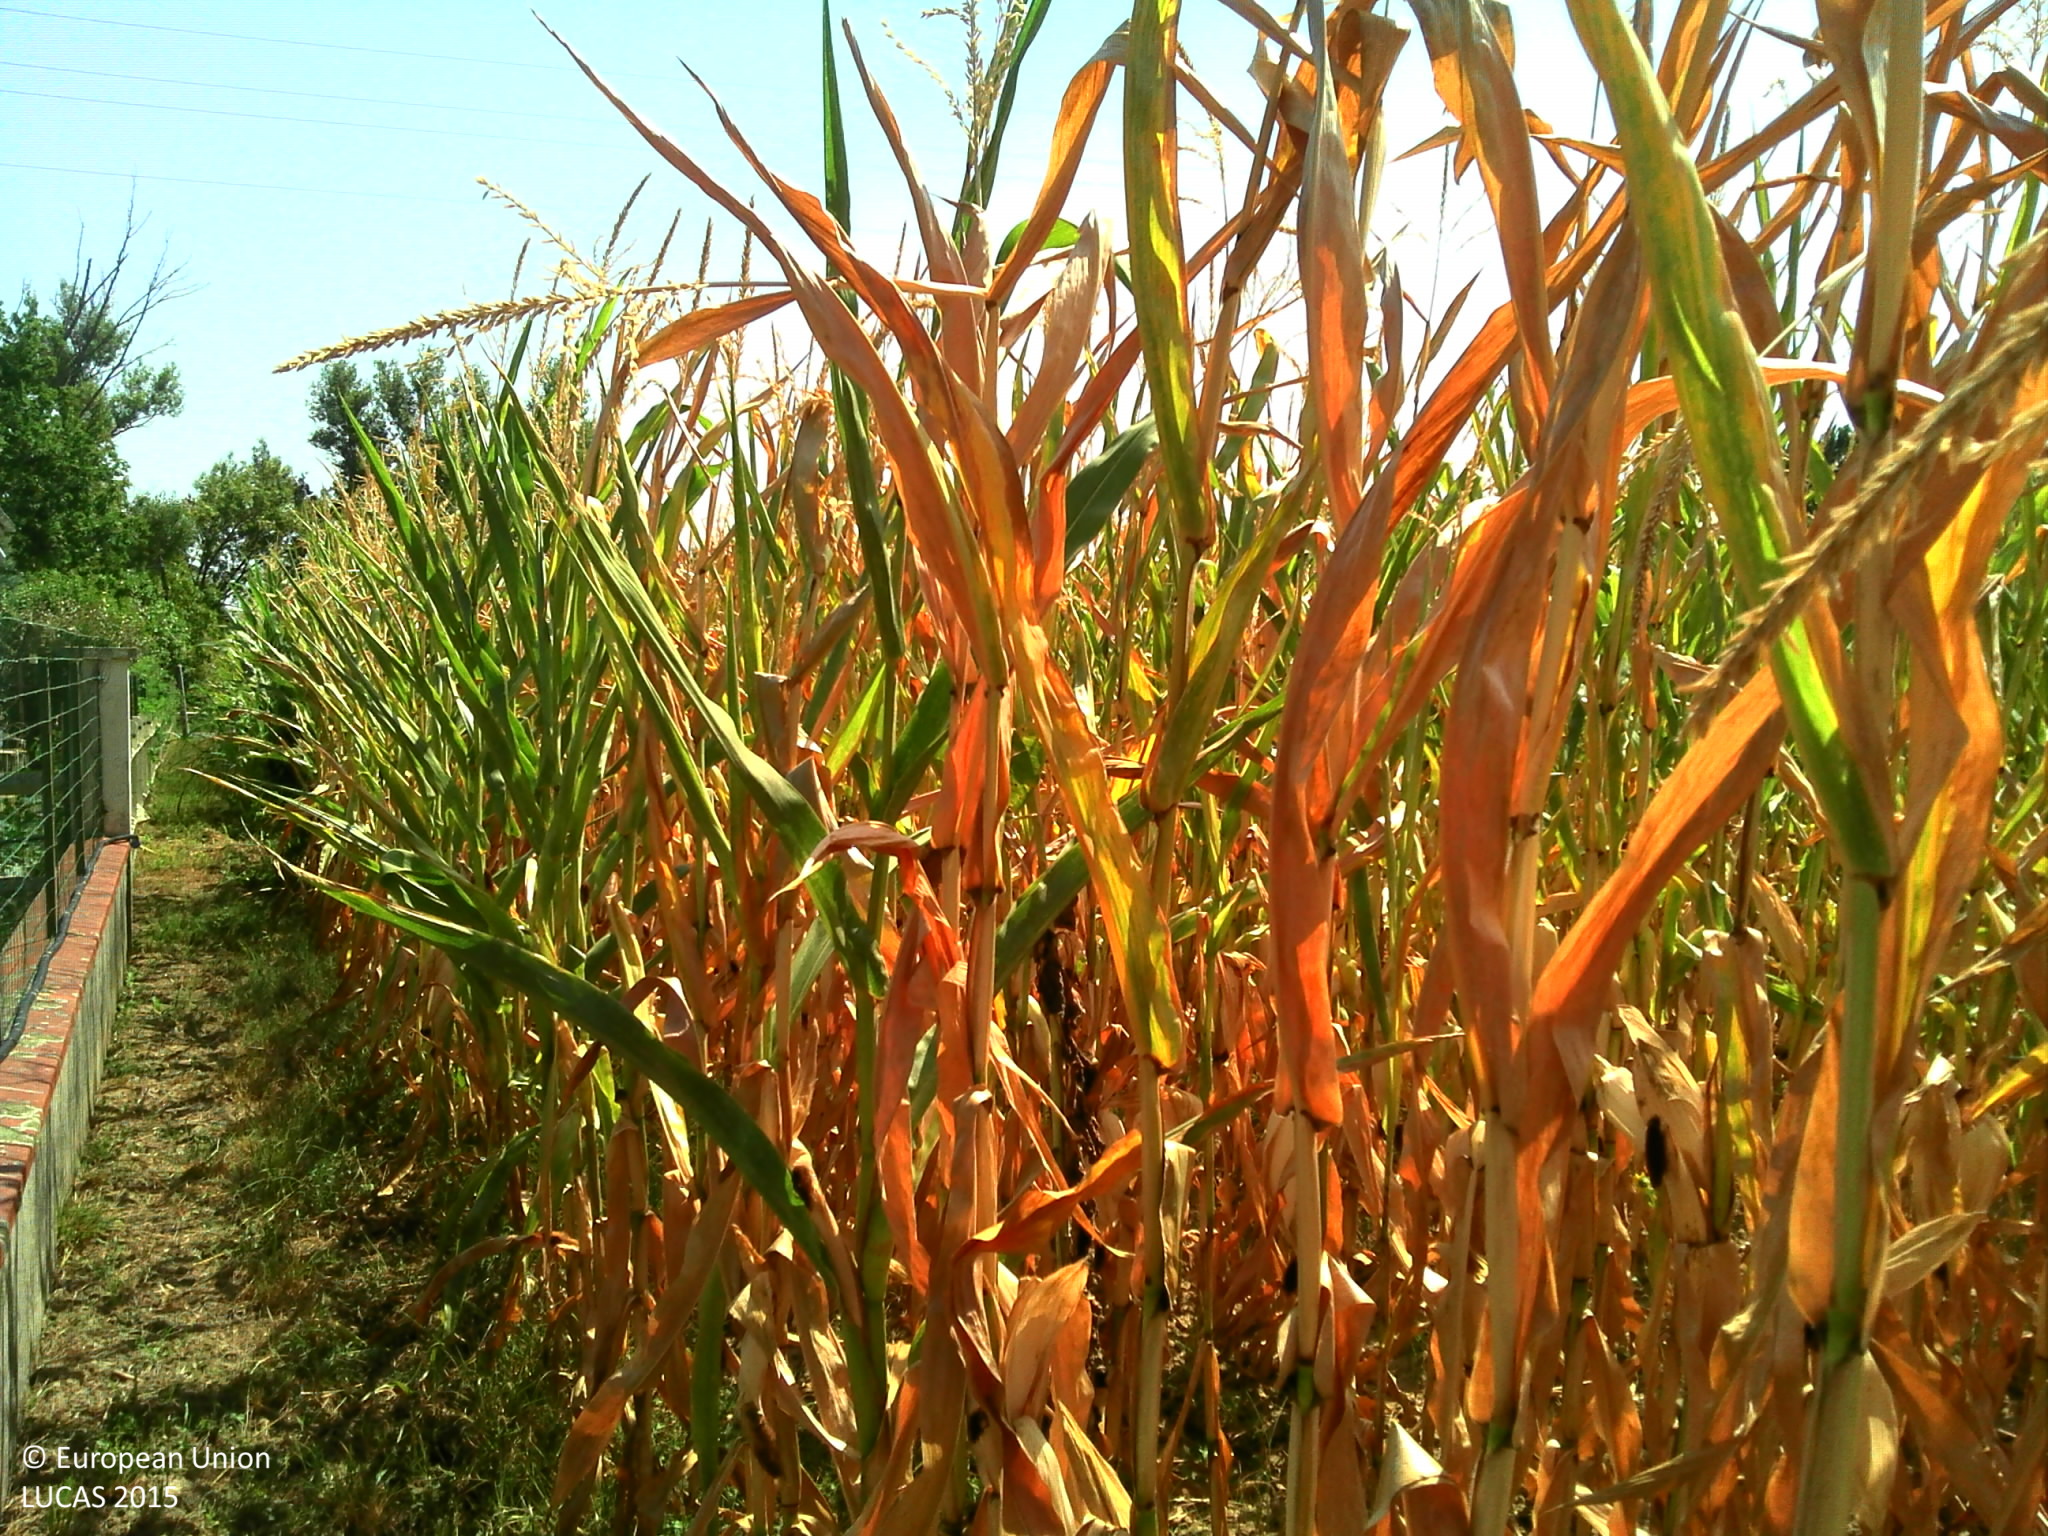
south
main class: Grassland
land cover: Grassland with sparse tree/shrub cover
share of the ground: > 75 %
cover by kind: herbaceous plants 90 %, broadleaved forest trees 5 %, shrubs 5 %
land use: Residential
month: August
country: FR
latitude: 44.1661
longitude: 0.6784
